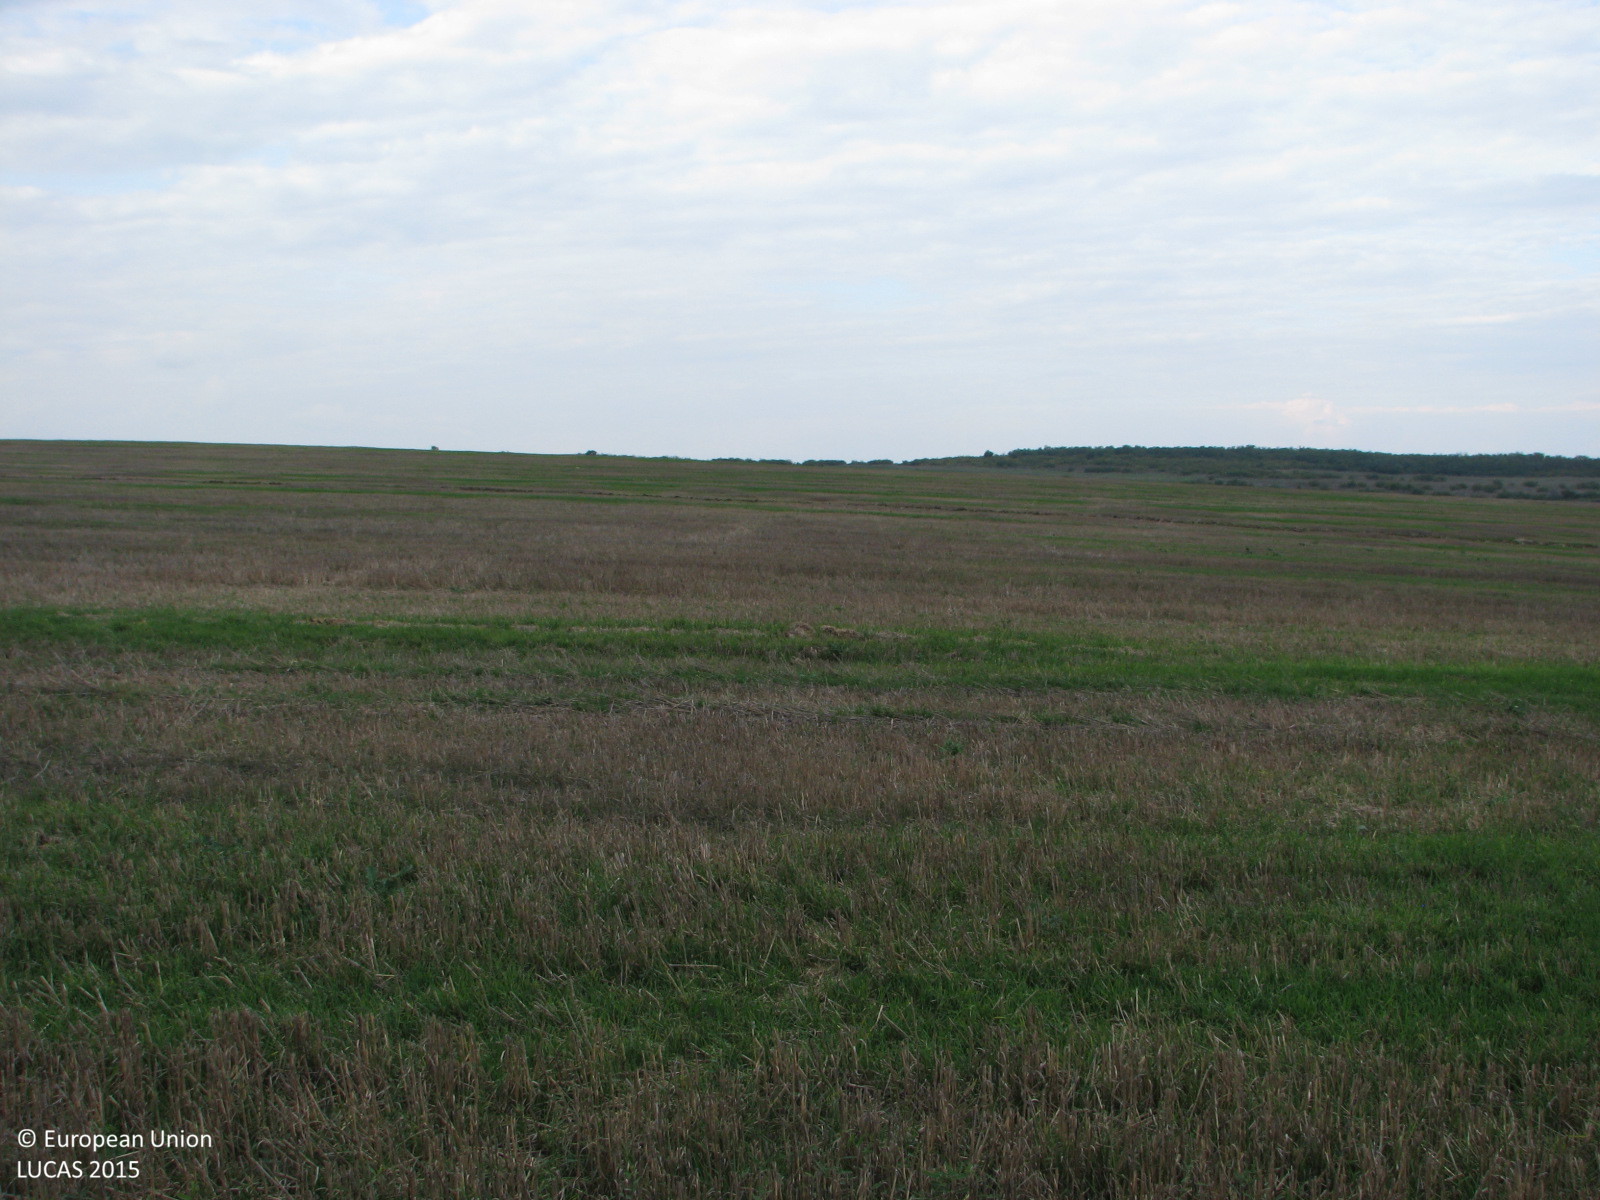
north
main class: Cropland
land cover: Common wheat
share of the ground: > 75 %
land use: Agriculture (excluding fallow land and kitchen gardens)
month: October
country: BG
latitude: 42.2739
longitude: 26.4446
